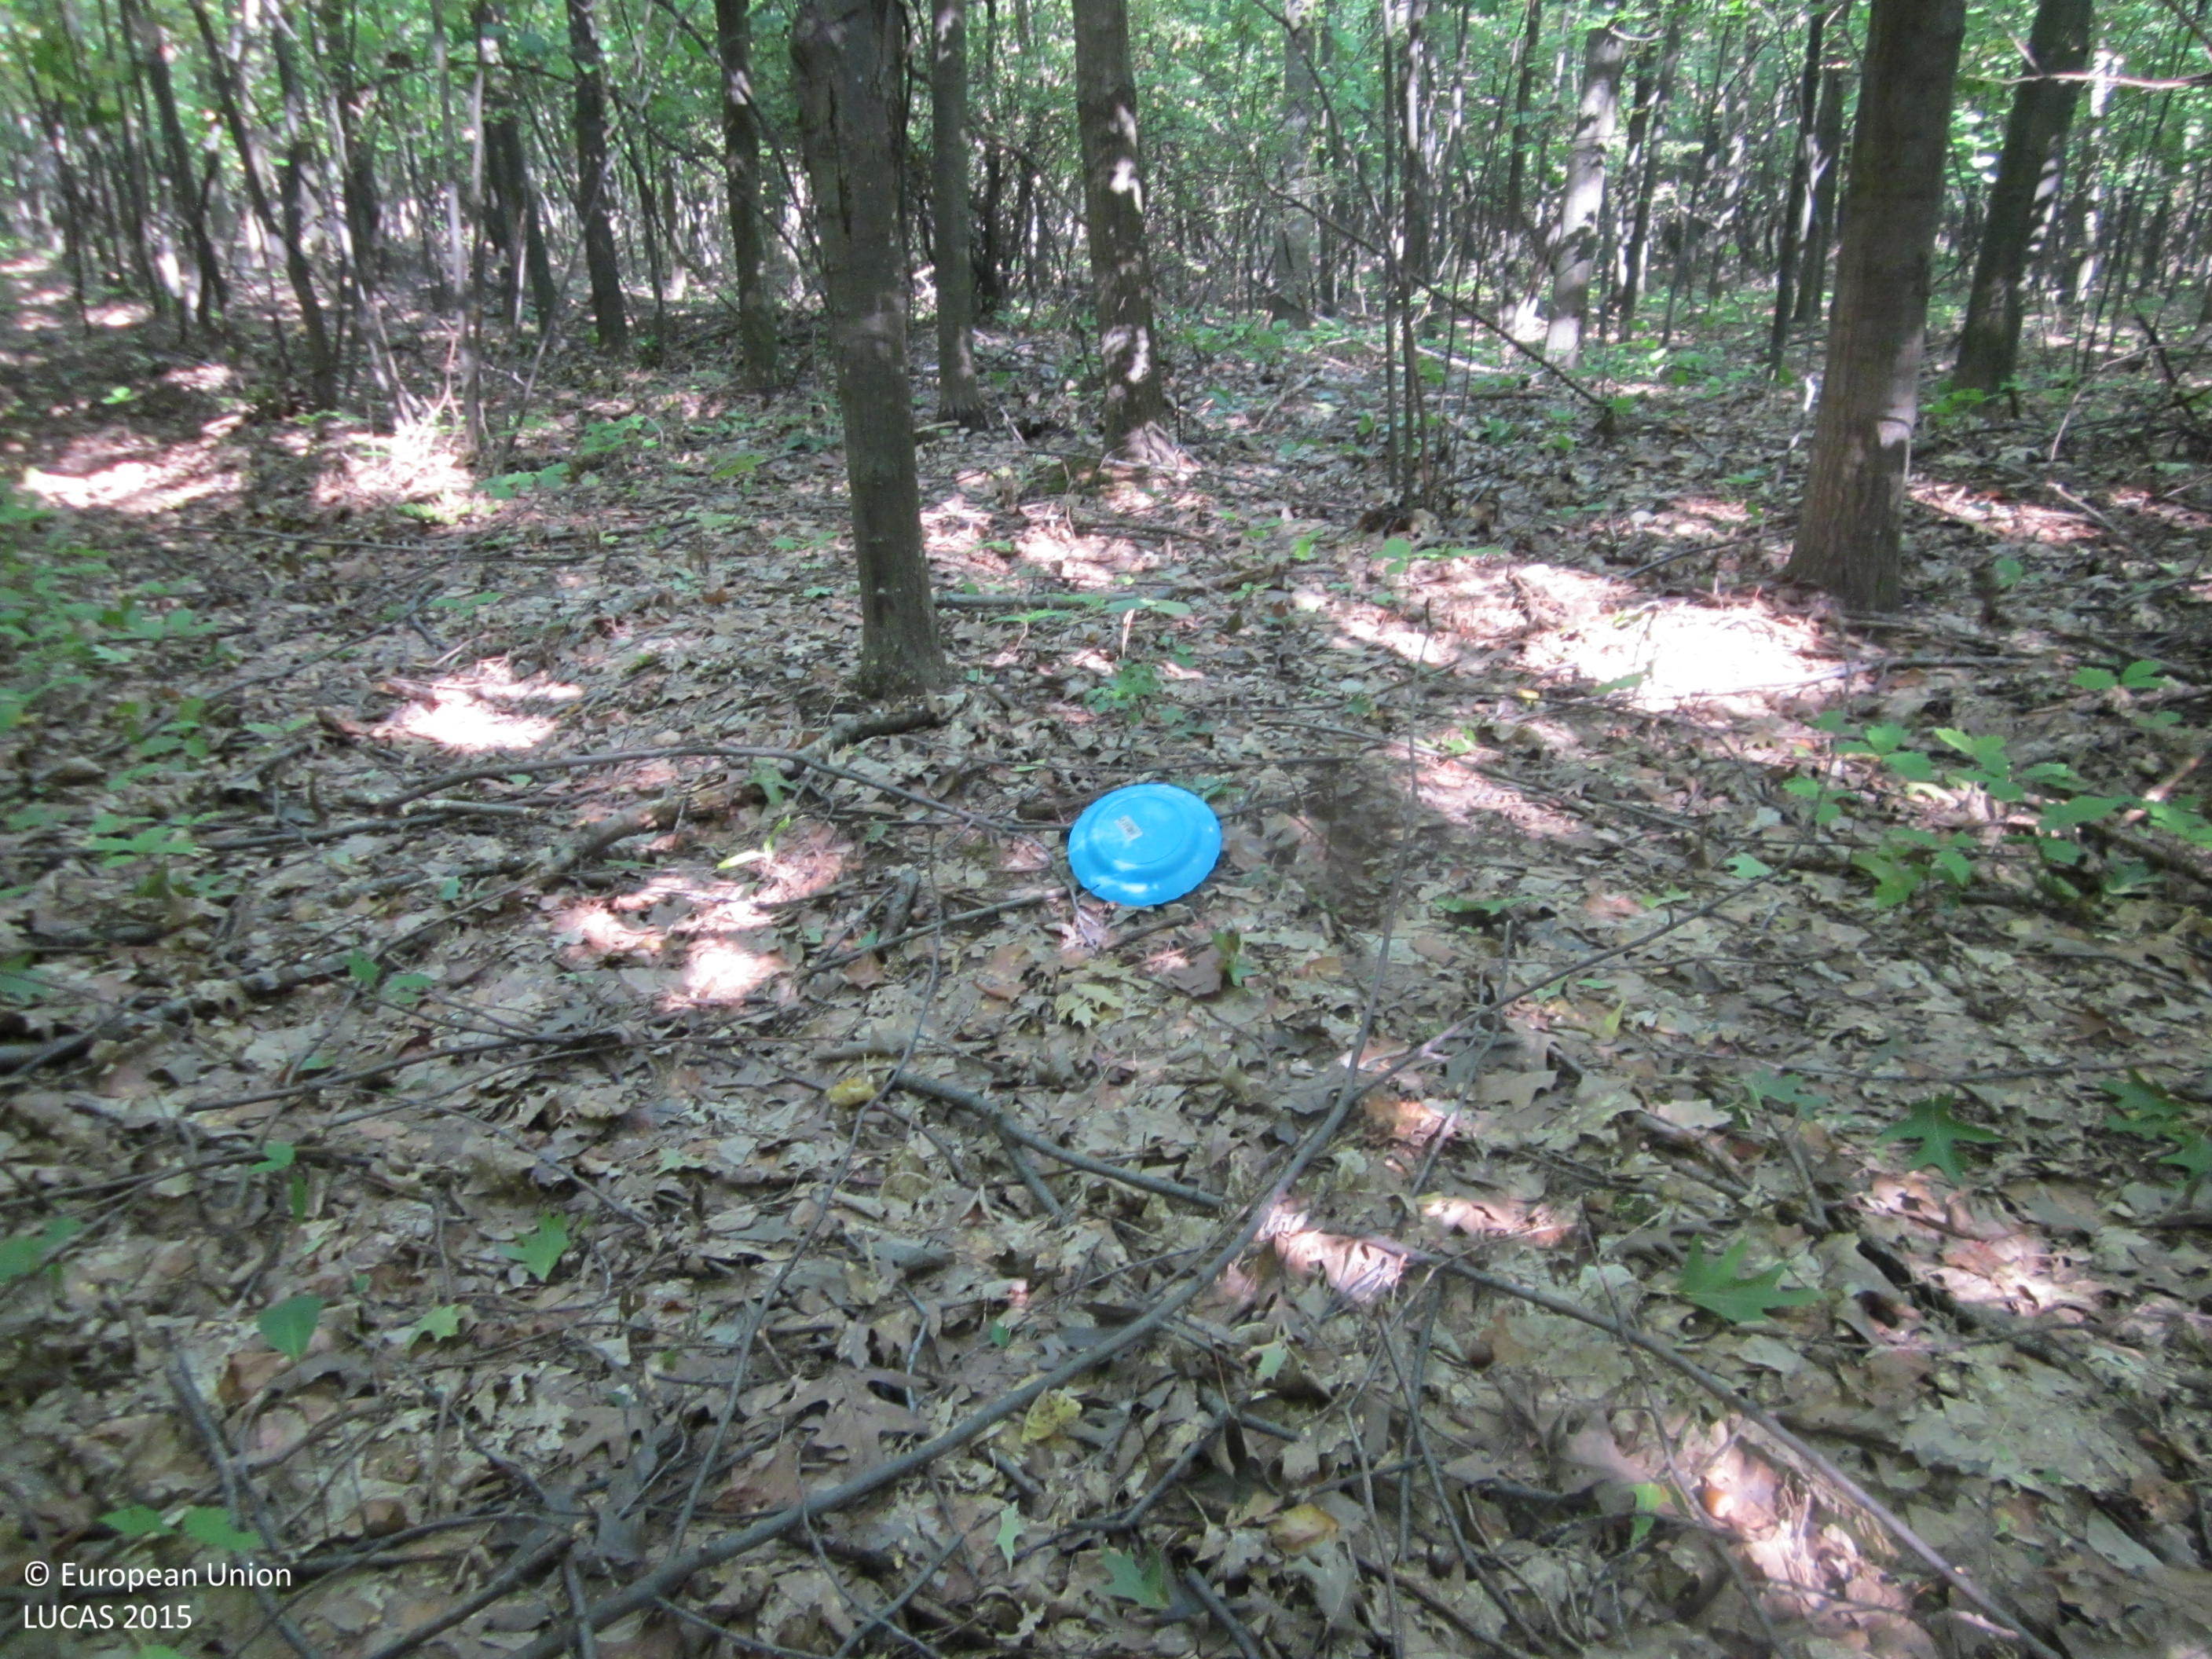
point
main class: Woodland
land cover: Broadleaved woodland
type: acidophilous oak and oak-birch forest
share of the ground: 50 - 75 %
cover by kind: broadleaved forest trees 70 %, unconsolidated bare surface 20 %, herbaceous plants 10 %
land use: Forestry
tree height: > 5 m
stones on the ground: < 10 %
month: October
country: BG
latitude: 42.8162
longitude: 26.7228
